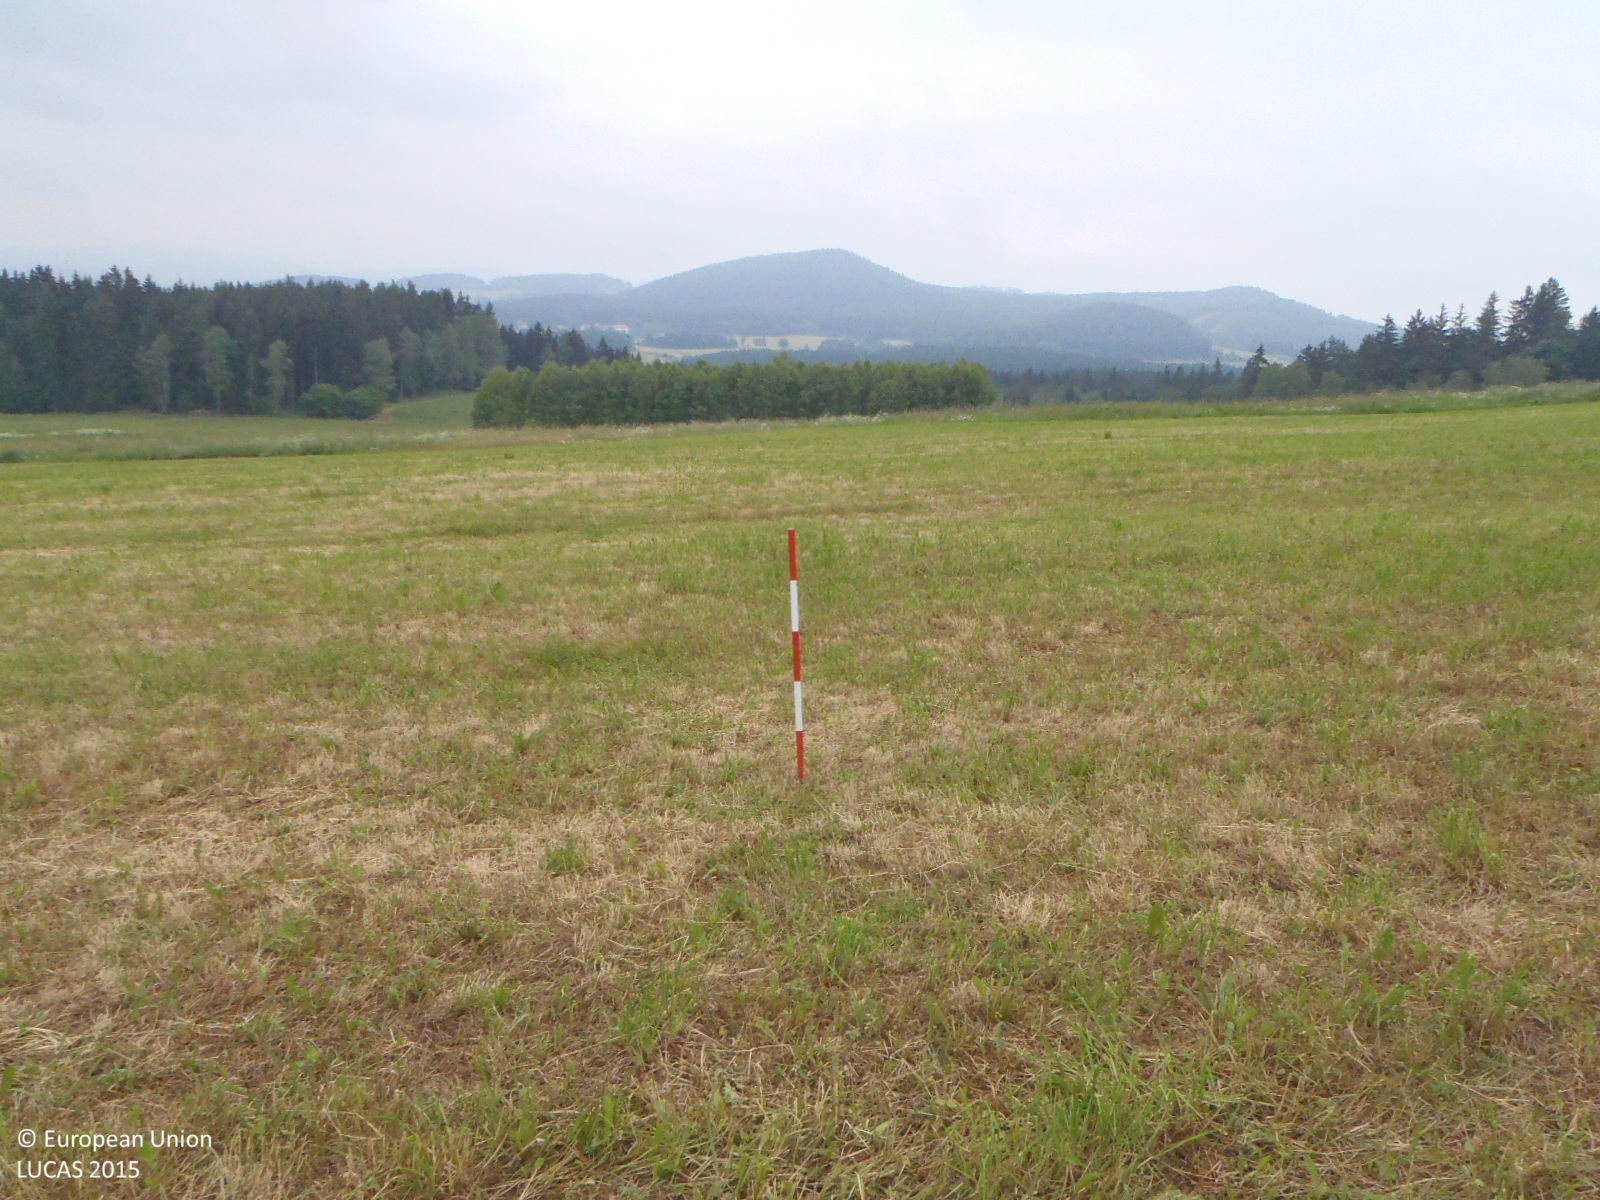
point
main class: Grassland
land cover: Grassland without tree/shrub cover
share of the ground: > 75 %
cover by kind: herbaceous plants 100 %
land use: Agriculture (excluding fallow land and kitchen gardens)
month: June
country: CZ
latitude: 48.6071
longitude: 14.3269
